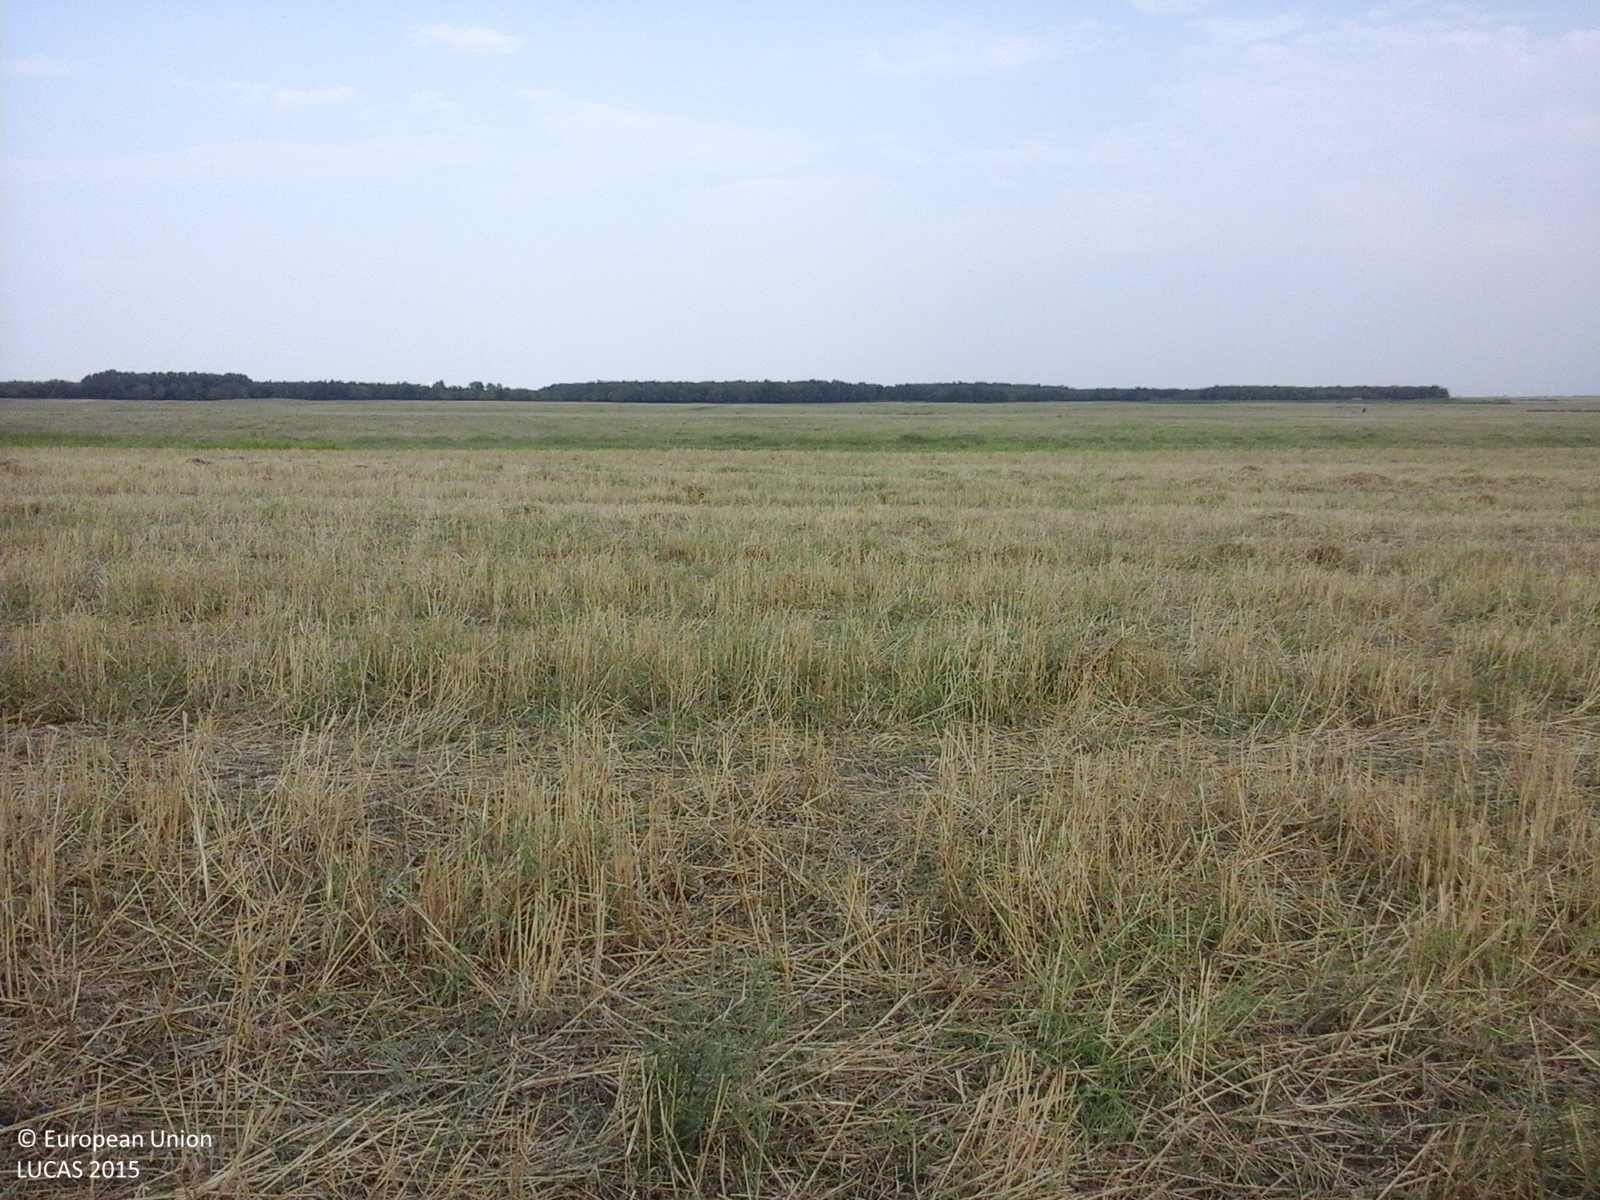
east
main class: Cropland
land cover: Barley
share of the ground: 50 - 75 %
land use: Agriculture (excluding fallow land and kitchen gardens)
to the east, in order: Barley; Ditches and canals; Grassland without tree/shrub cover
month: August
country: RO
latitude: 45.2545
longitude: 27.5458
